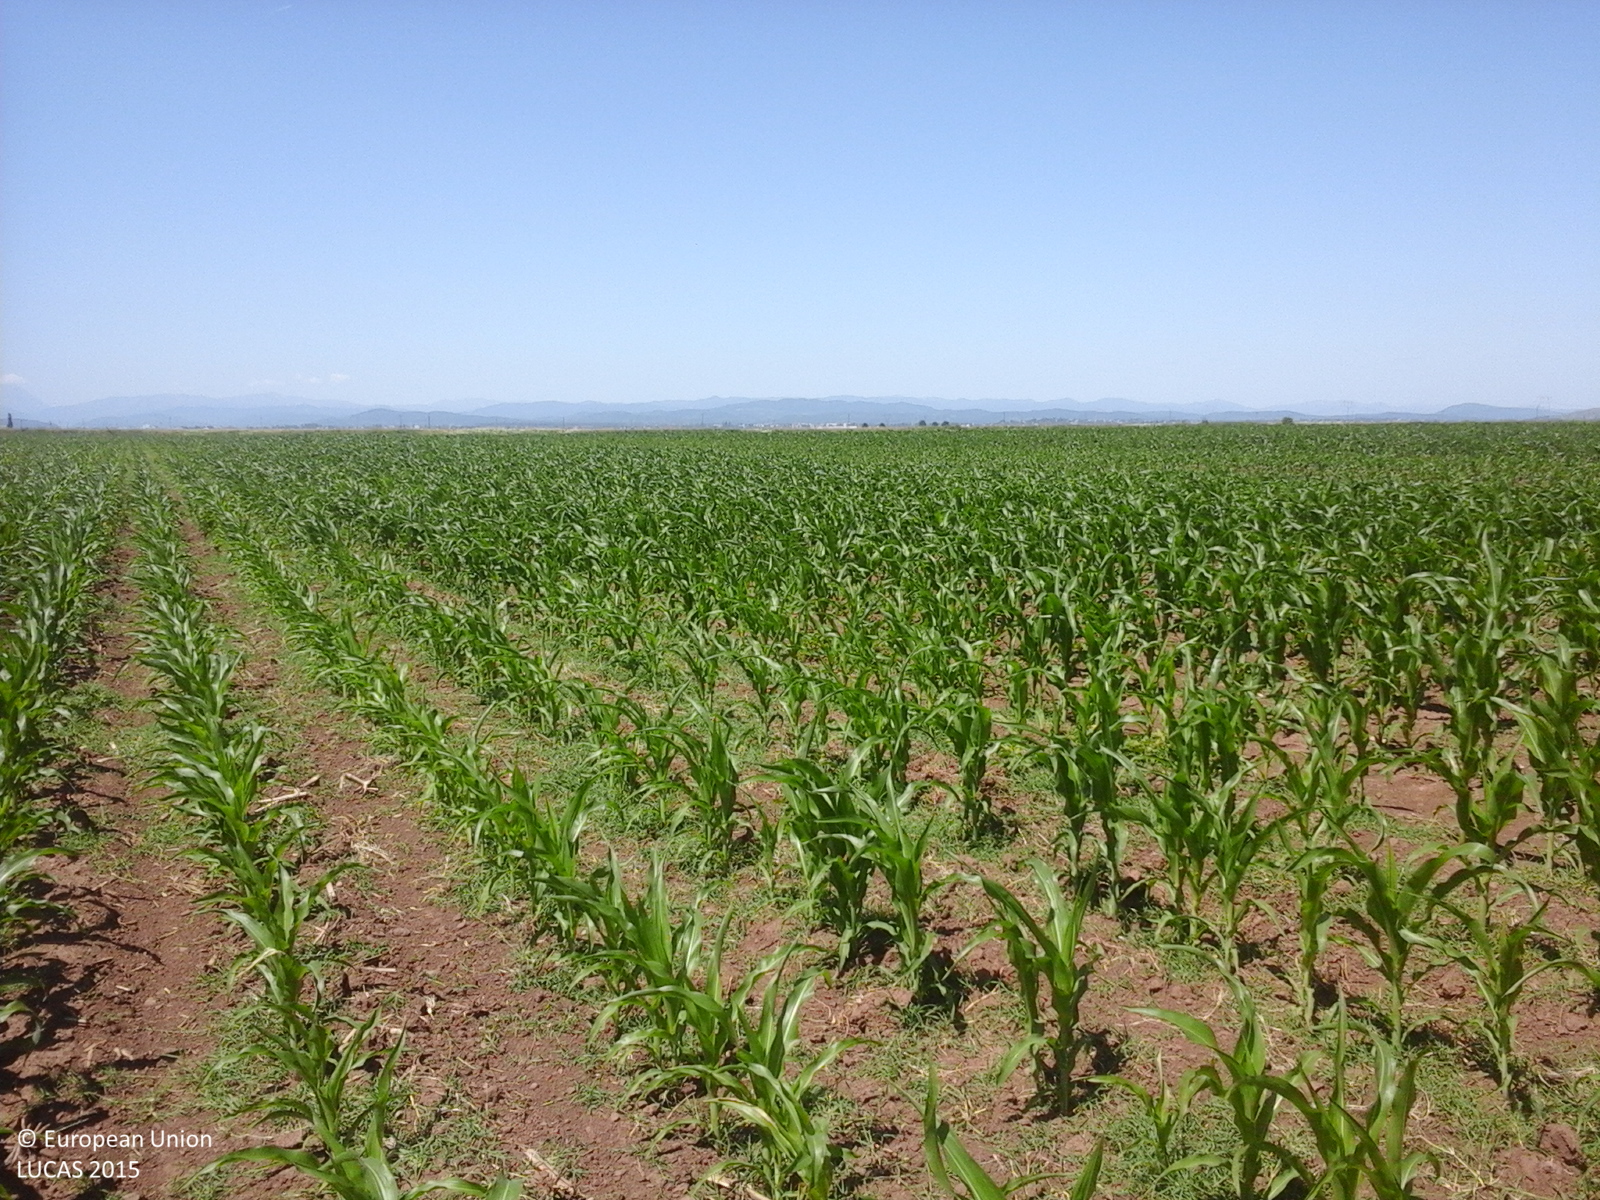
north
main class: Cropland
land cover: Maize
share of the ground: 25 - 50 %
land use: Agriculture (excluding fallow land and kitchen gardens)
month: June
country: RO
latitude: 44.9602
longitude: 25.8362
